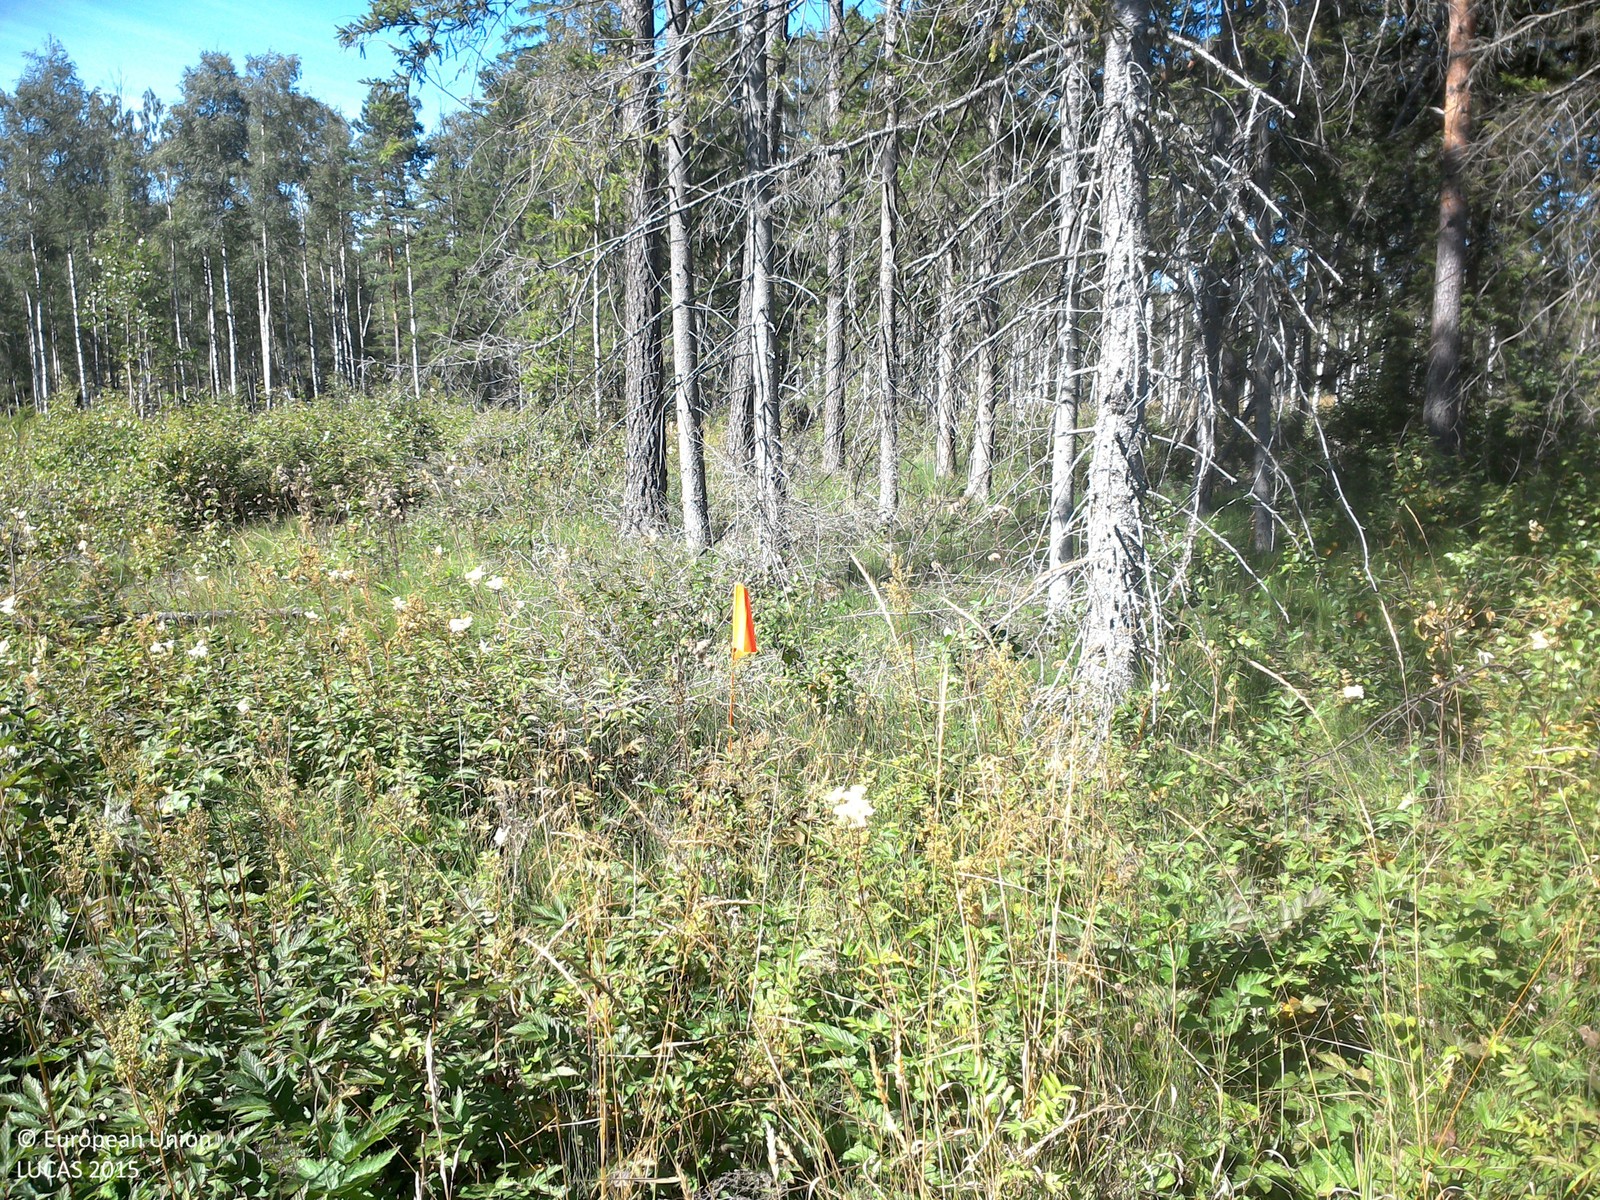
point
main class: Grassland
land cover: Spontaneously vegetated surfaces
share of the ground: > 75 %
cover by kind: herbaceous plants 95 %, shrubs 5 %
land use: Forestry
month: August
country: SE
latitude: 58.2866
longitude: 15.0598
